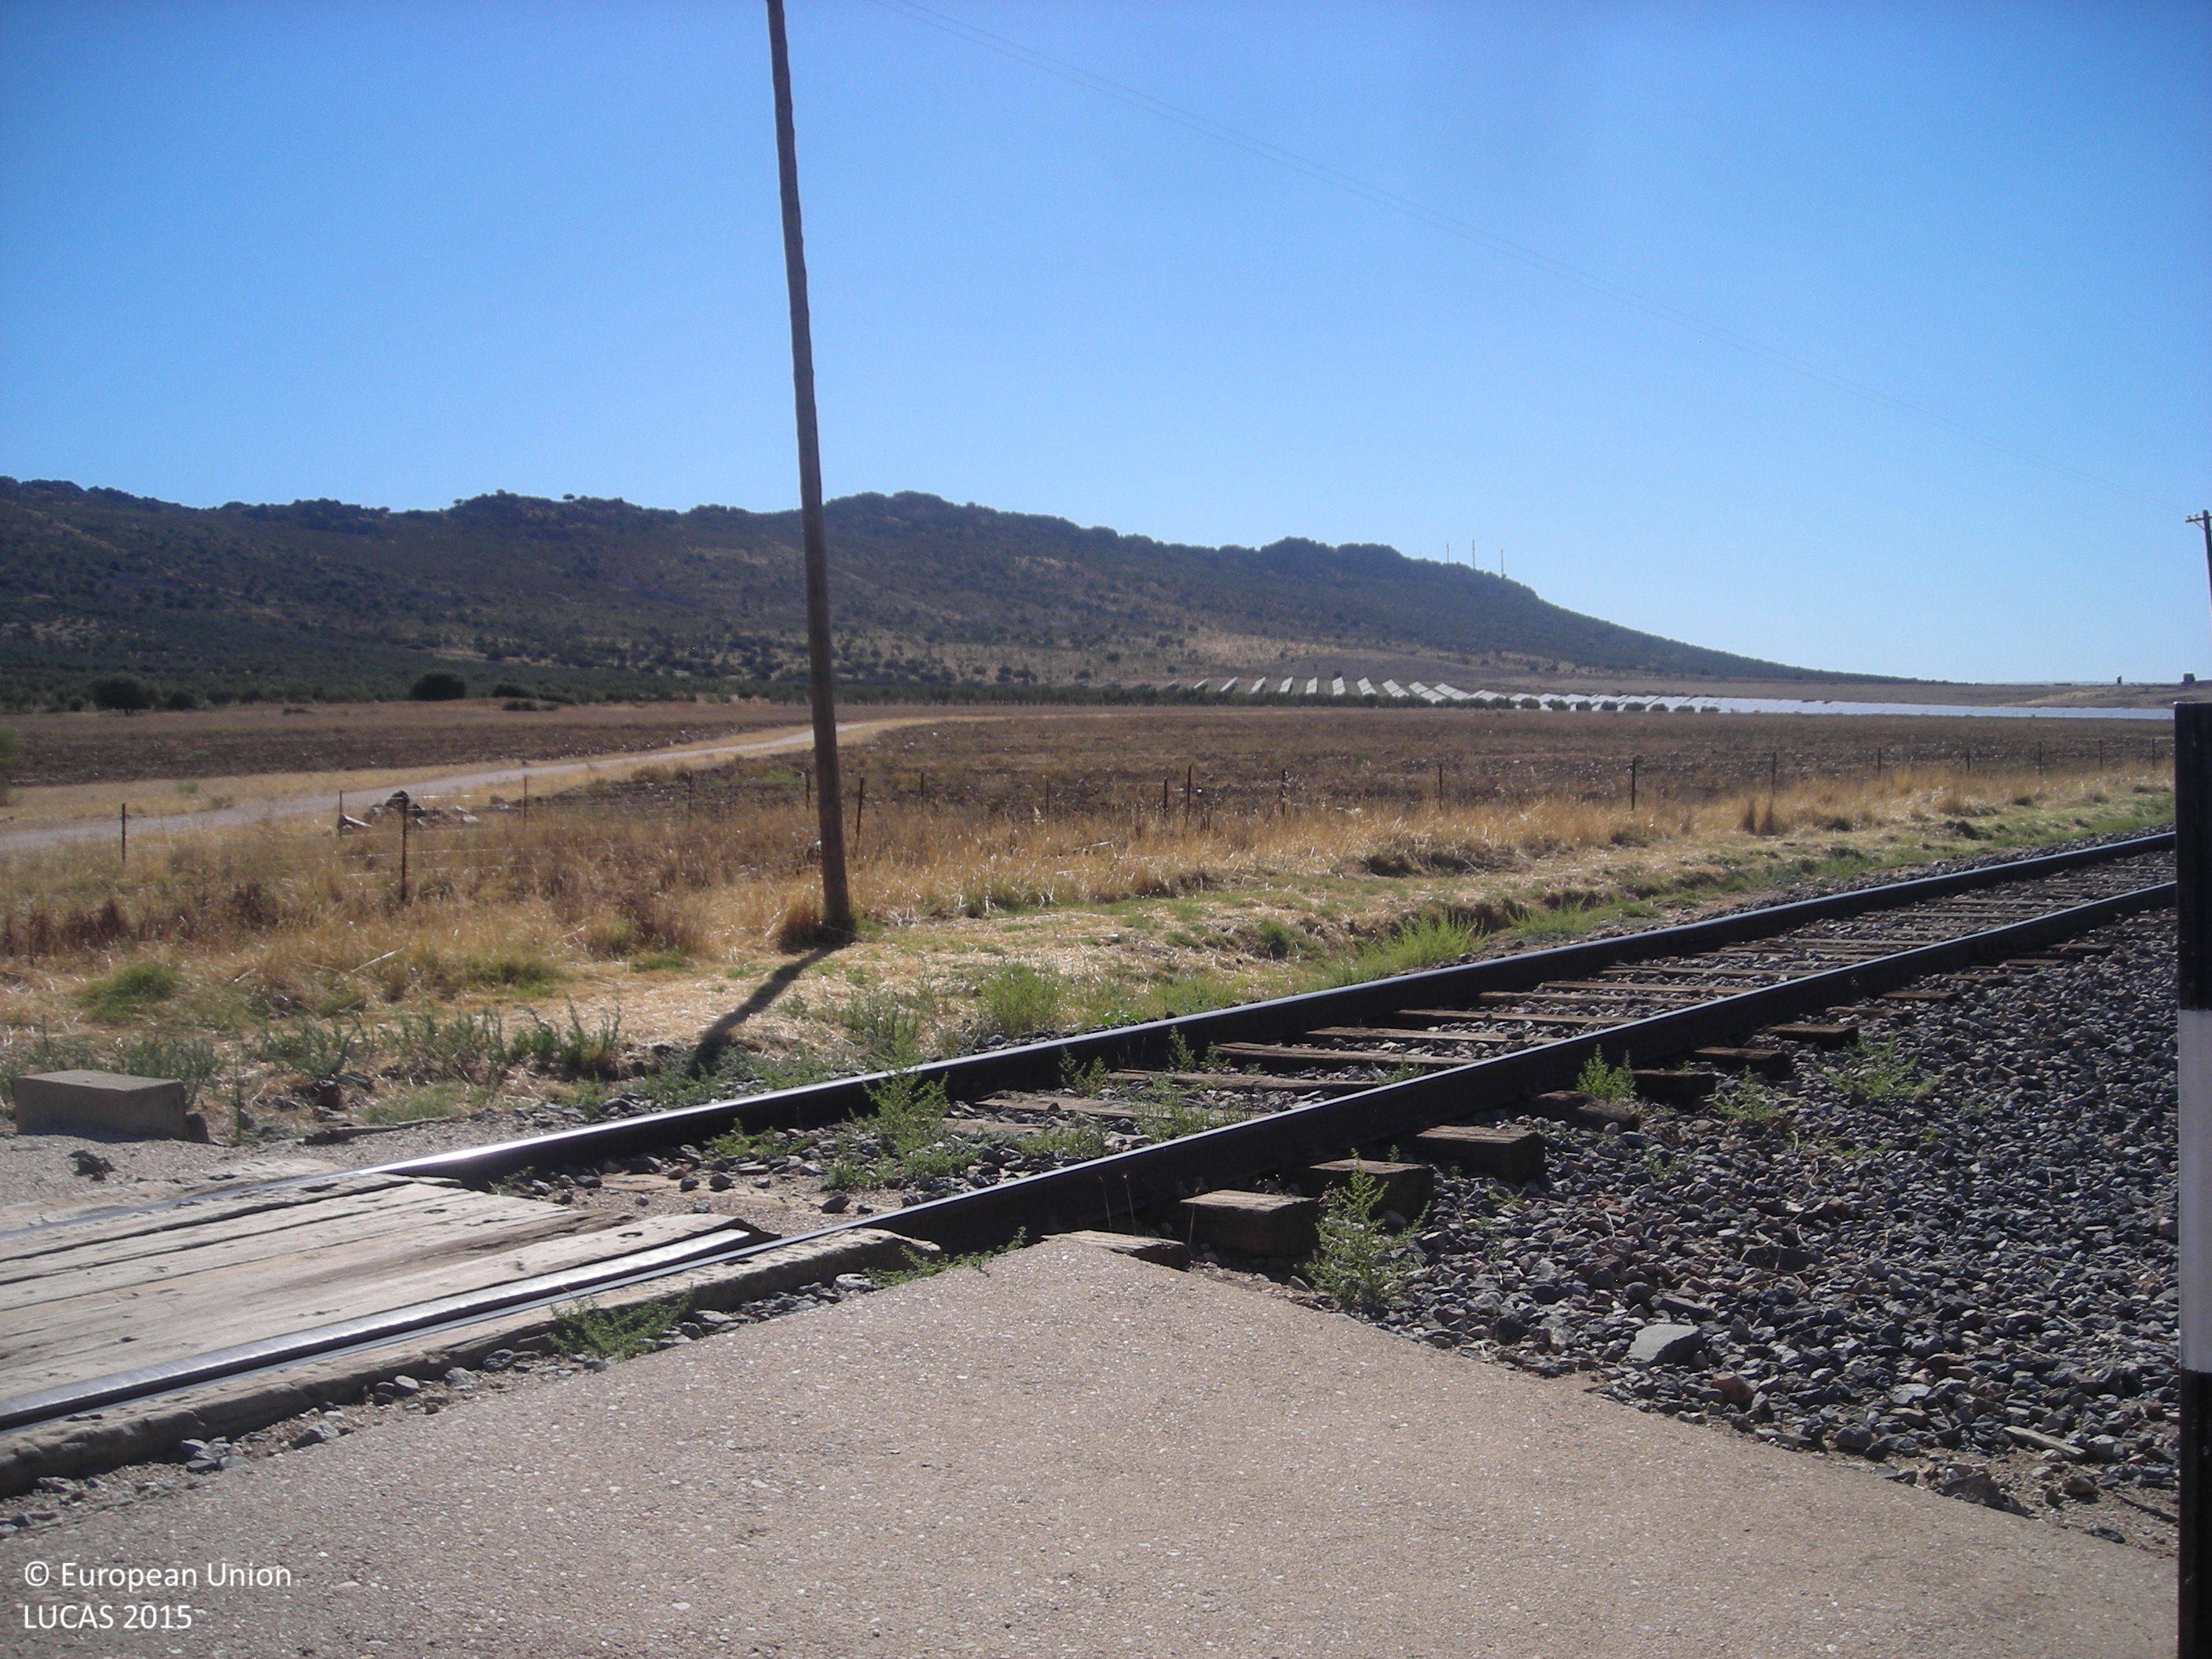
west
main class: Grassland
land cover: Grassland without tree/shrub cover
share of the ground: > 75 %
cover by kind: herbaceous plants 100 %
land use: Agriculture (excluding fallow land and kitchen gardens)
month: July
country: ES
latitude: 38.7169
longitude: -5.4846
